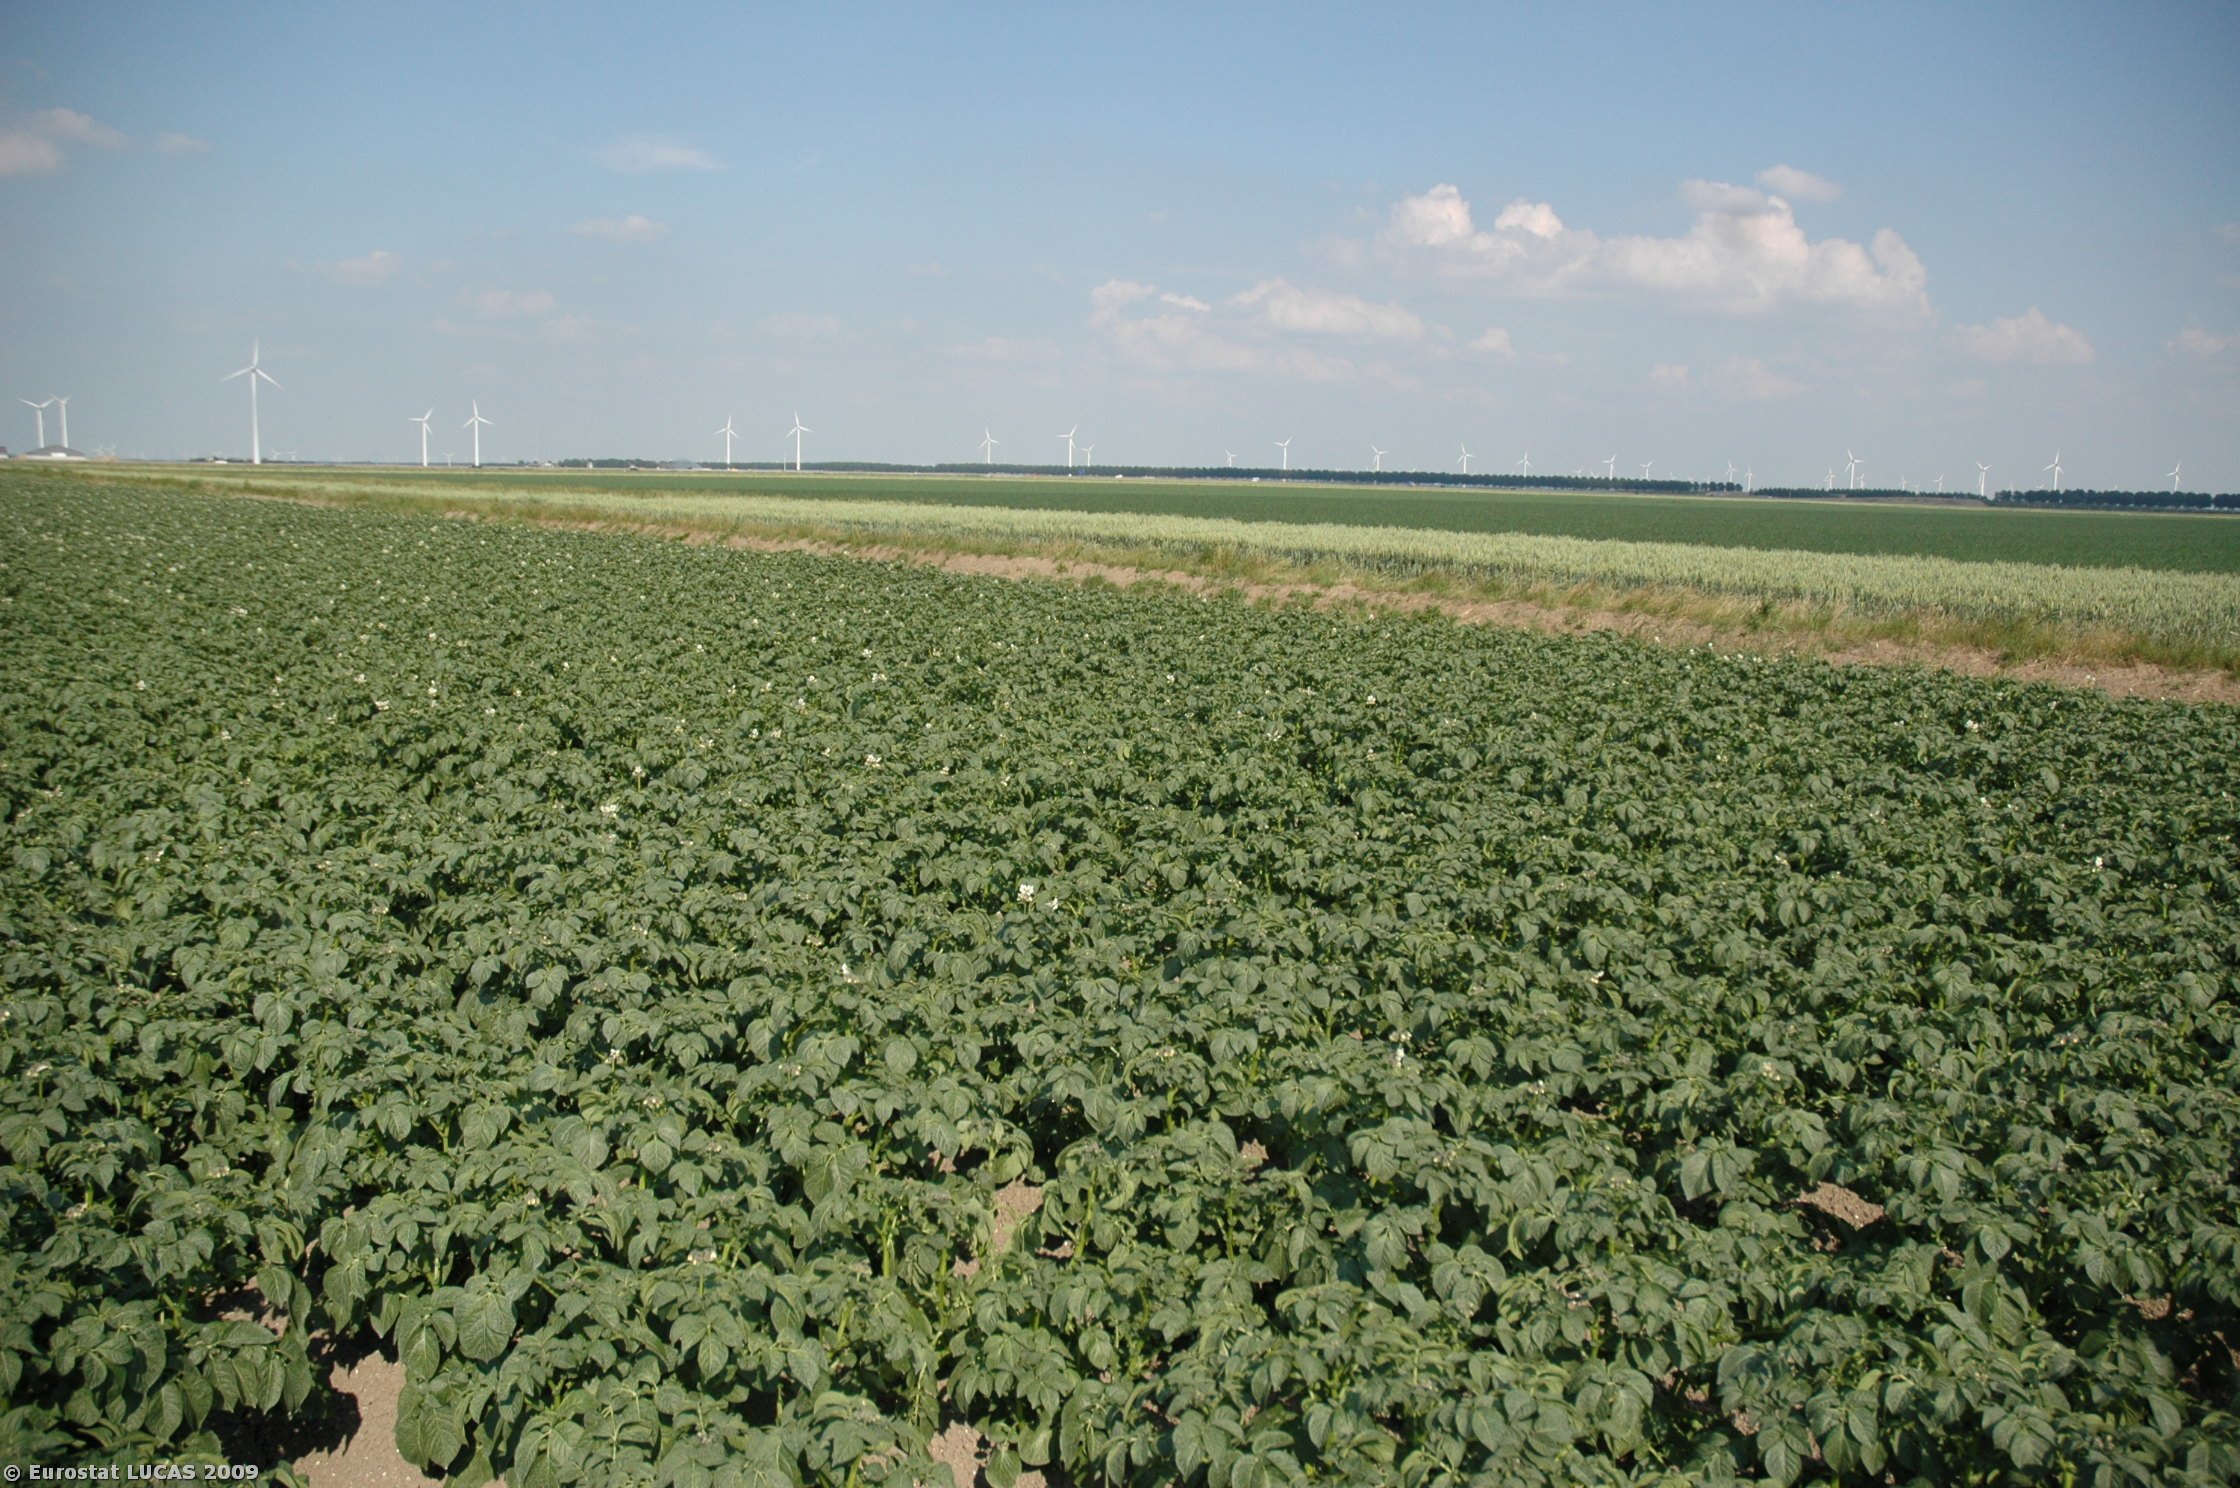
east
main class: Cropland
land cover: Potatoes
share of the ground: > 75 %
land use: Agriculture (excluding fallow land and kitchen gardens)
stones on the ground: < 10 %
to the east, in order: Potatoes; Grassland without tree/shrub cover; Ditches and canals; Grass margins; Common wheat; Other fresh vegetables
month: June
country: NL
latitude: 52.3570
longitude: 5.3141
